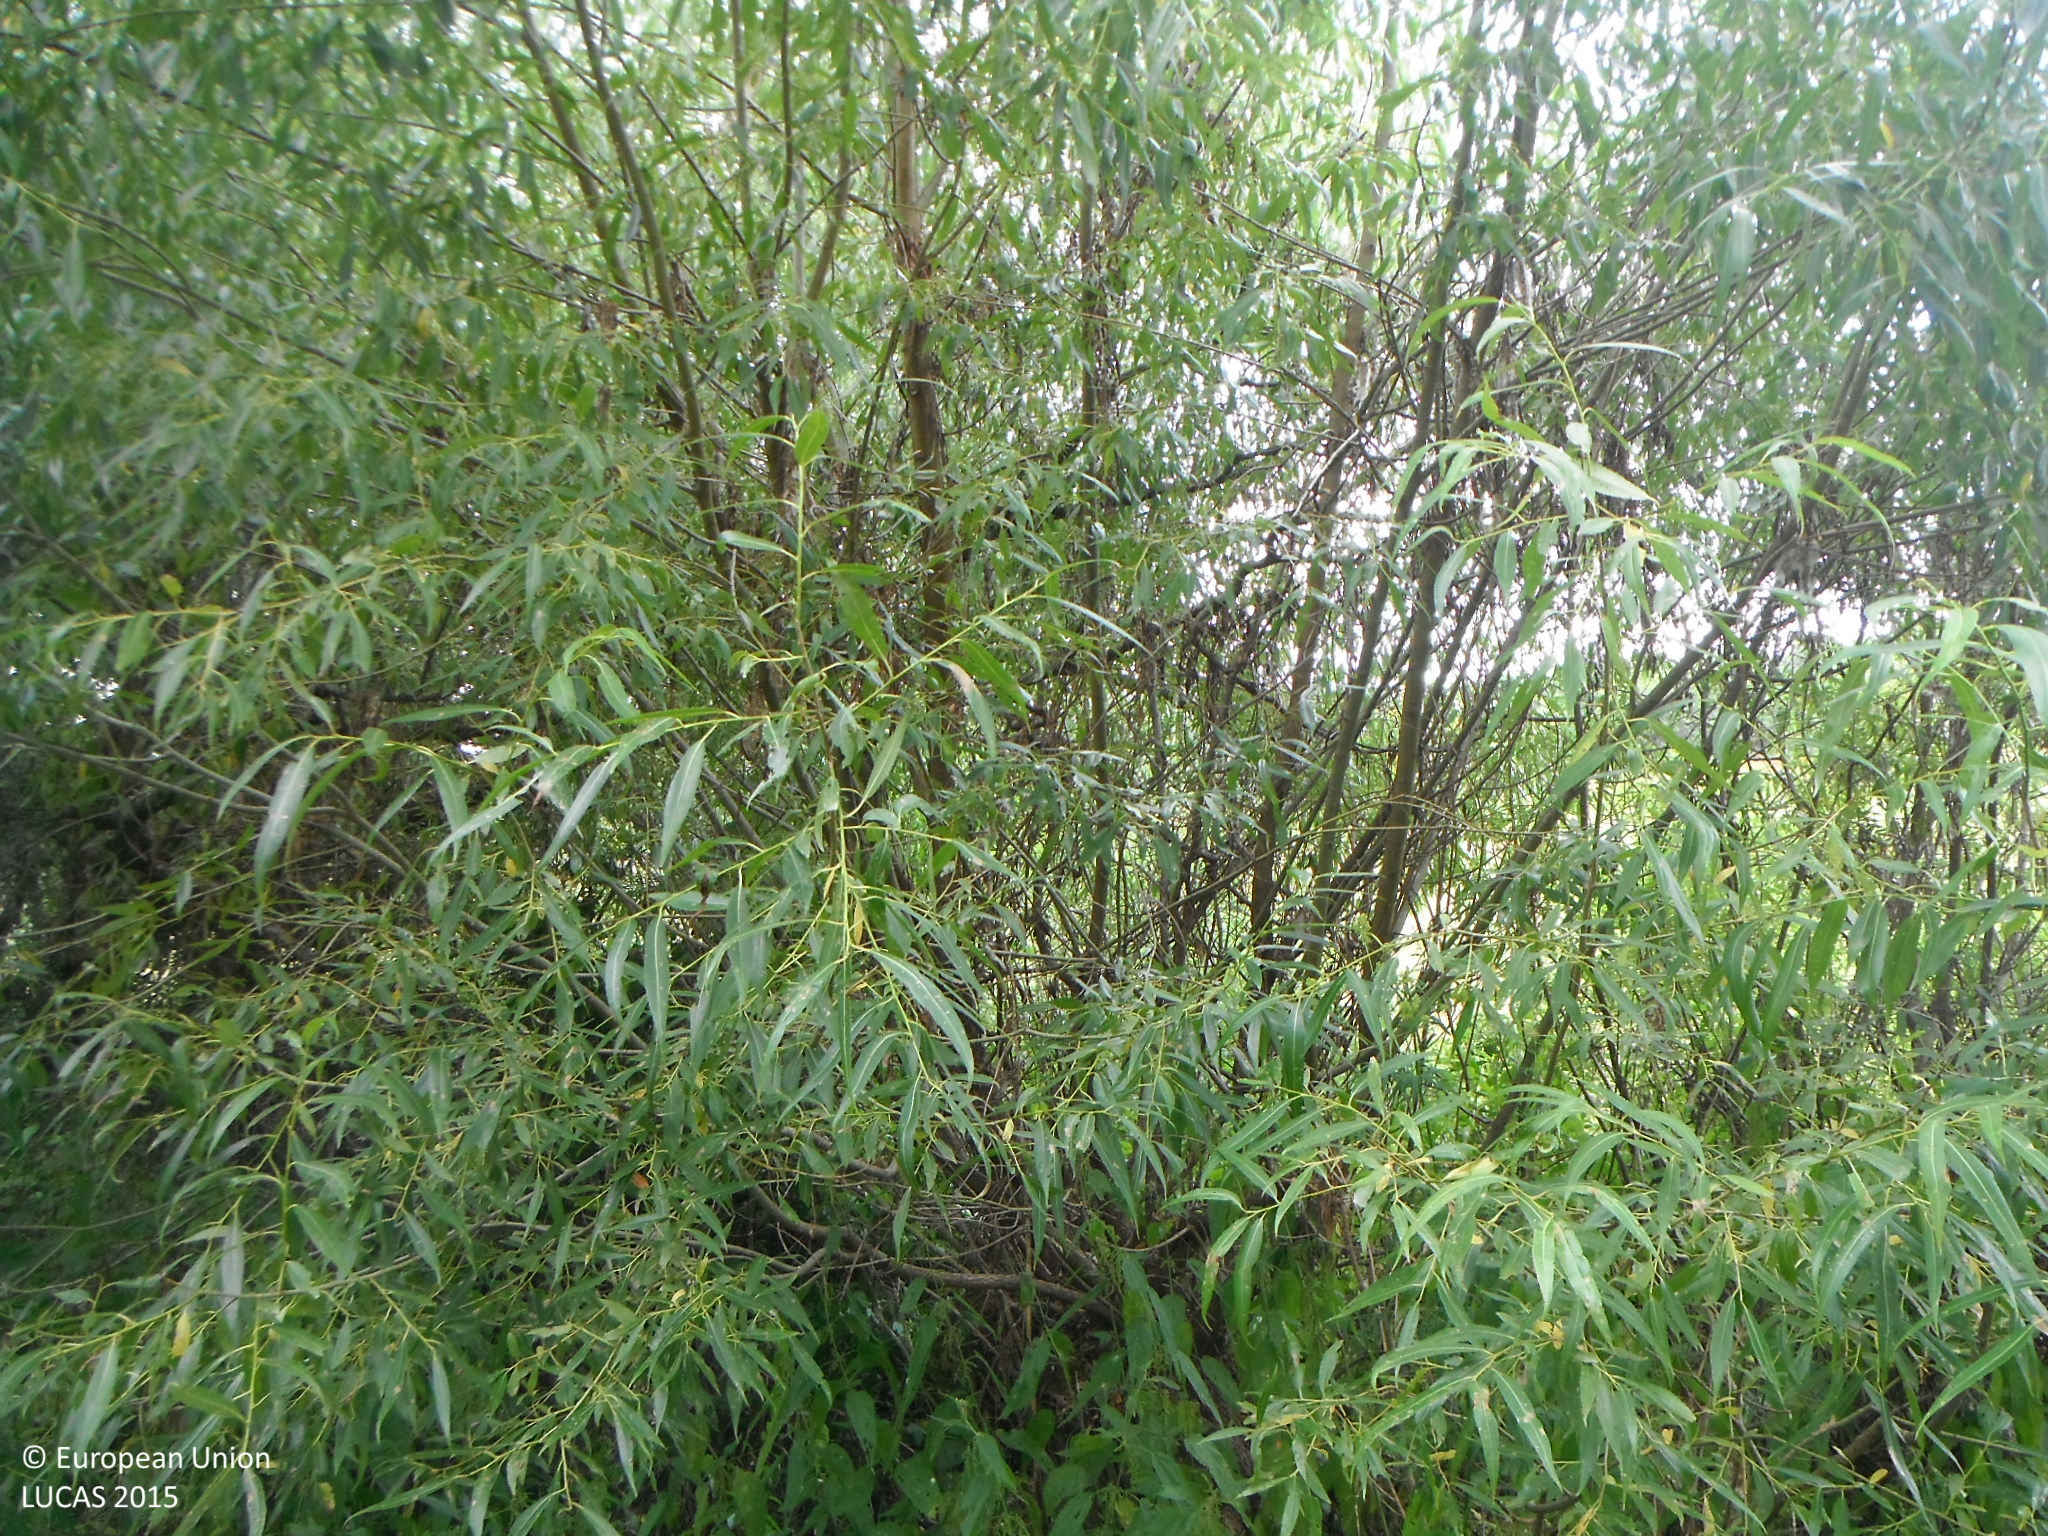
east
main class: Woodland
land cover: Broadleaved woodland
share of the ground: > 75 %
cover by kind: broadleaved forest trees 90 %, herbaceous plants 10 %
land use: Semi-natural and natural areas not in use
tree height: > 5 m
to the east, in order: Broadleaved woodland; Grassland without tree/shrub cover; Electric lines; Grassland without tree/shrub cover; Spontaneously vegetated surfaces; Ditches and canals; Spontaneously vegetated surfaces; Paved roads, cycling and walking lanes; Grass margins; Ditches and canals; Grassland without tree/shrub cover; Electric lines; Grassland without tree/shrub cover; Broadleaved woodland; Shrubland with sparse tree cover
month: July
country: SK
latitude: 48.3666
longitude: 19.1599
